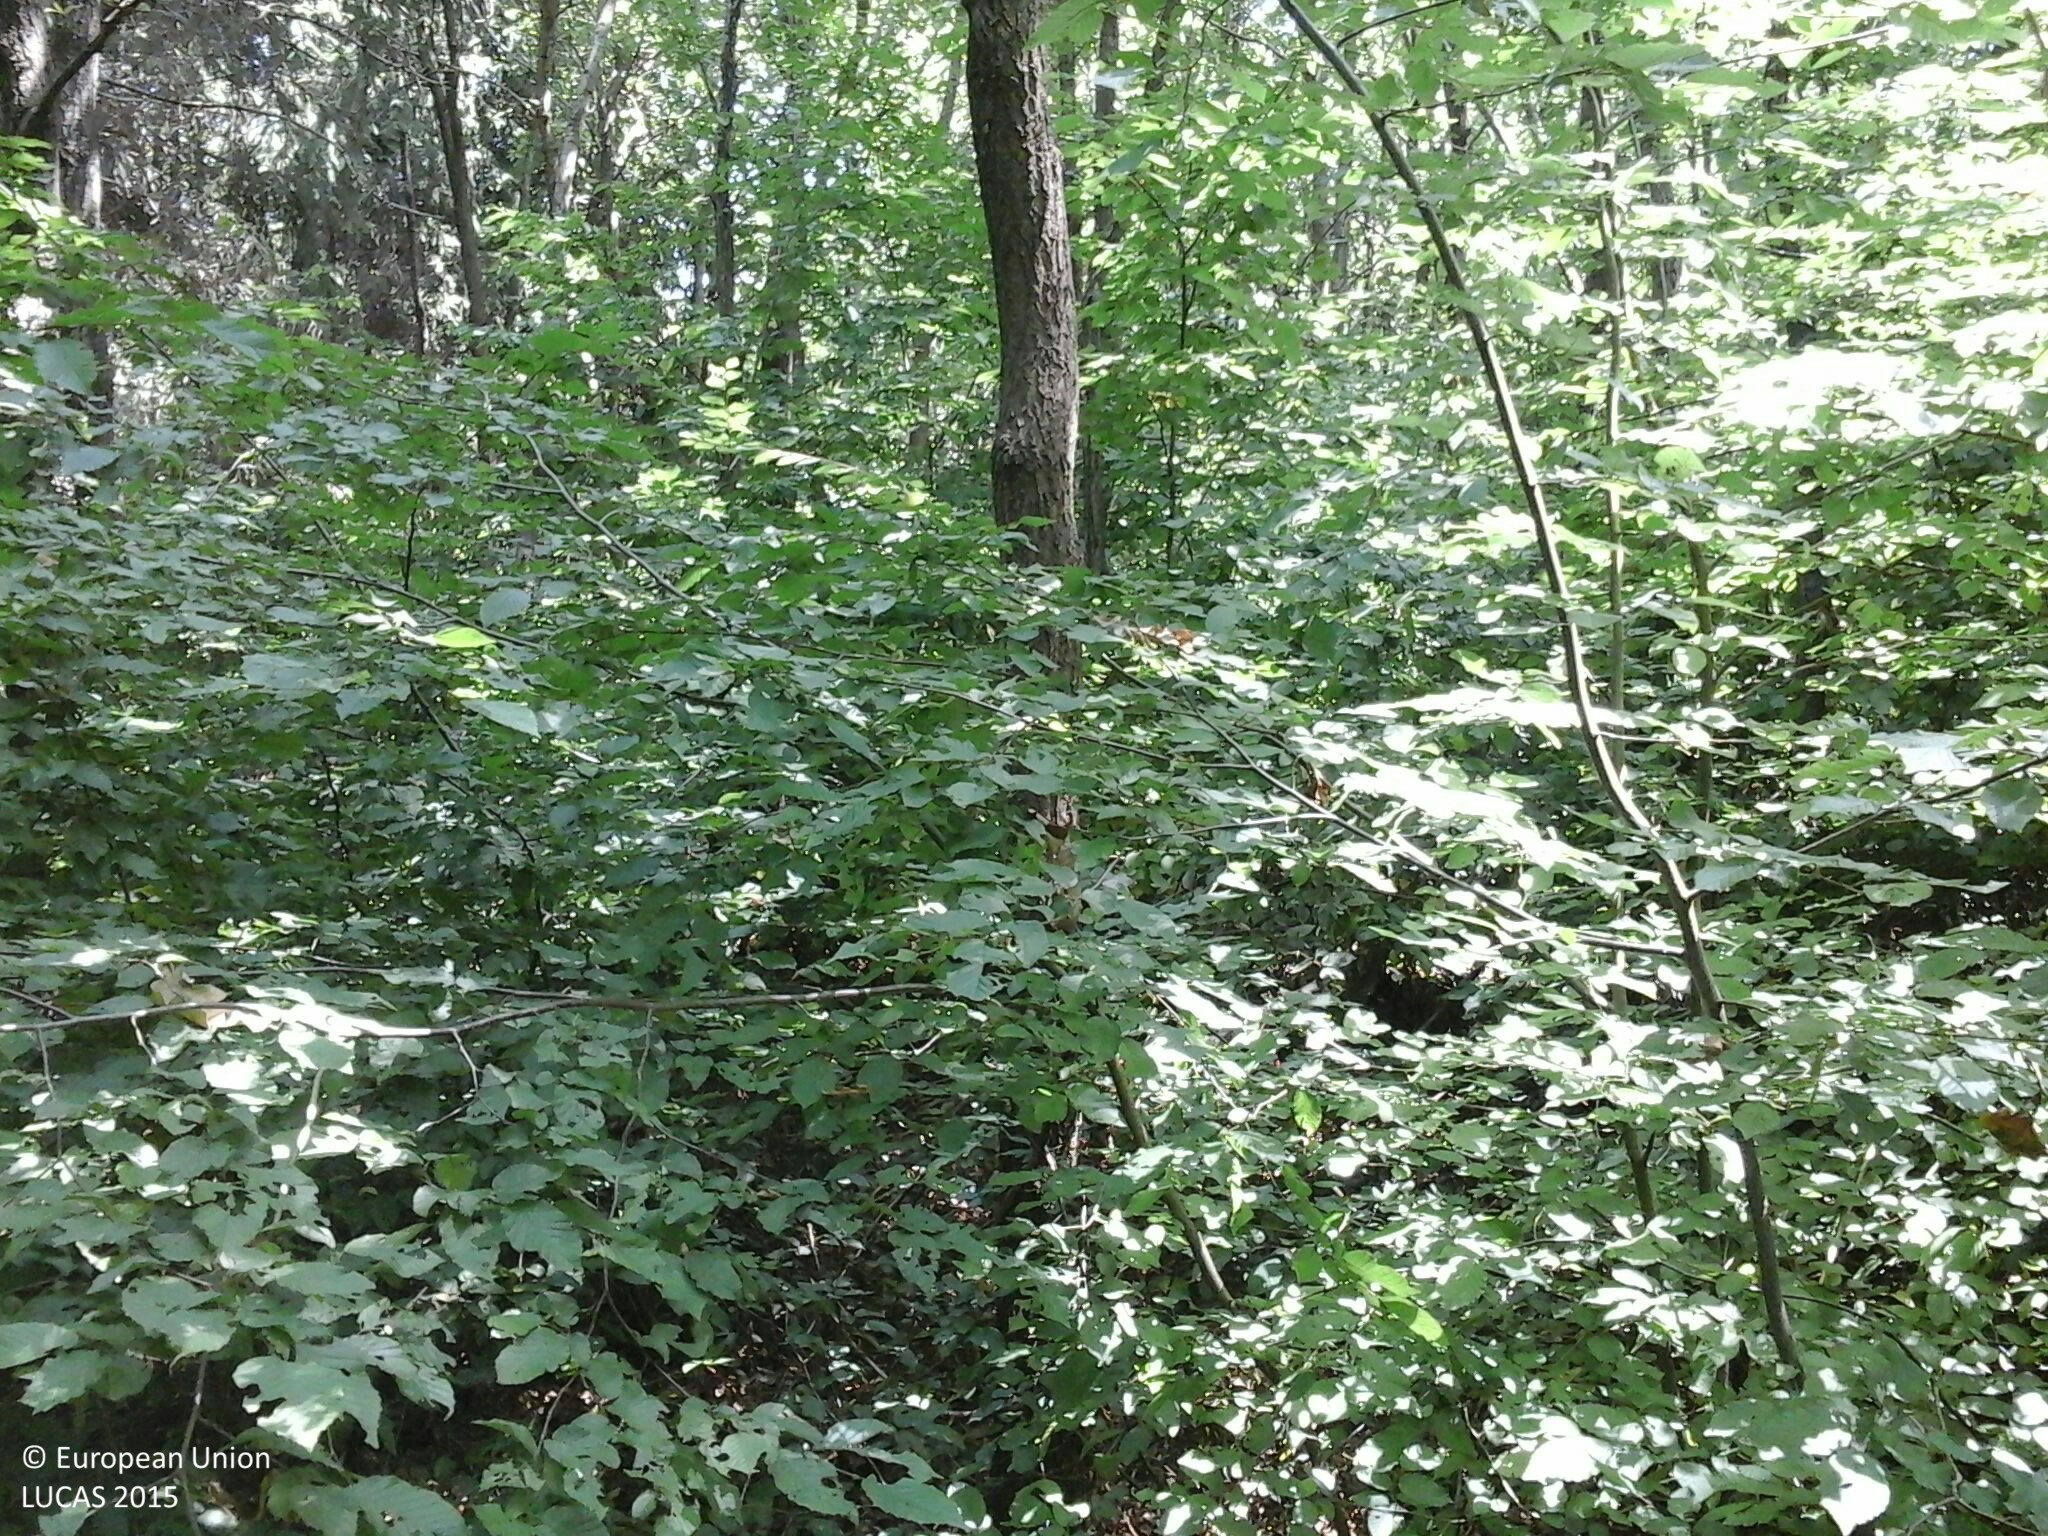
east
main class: Woodland
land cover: Broadleaved woodland
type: beech forest
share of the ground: > 75 %
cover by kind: broadleaved forest trees 75 %, coniferous forest trees 10 %, shrubs 10 %, herbaceous plants 5 %
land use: Forestry
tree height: > 5 m
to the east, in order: Broadleaved woodland; Ditches and canals; Shrubland without tree cover; Maize
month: July
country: HU
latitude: 46.9611
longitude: 16.5866
